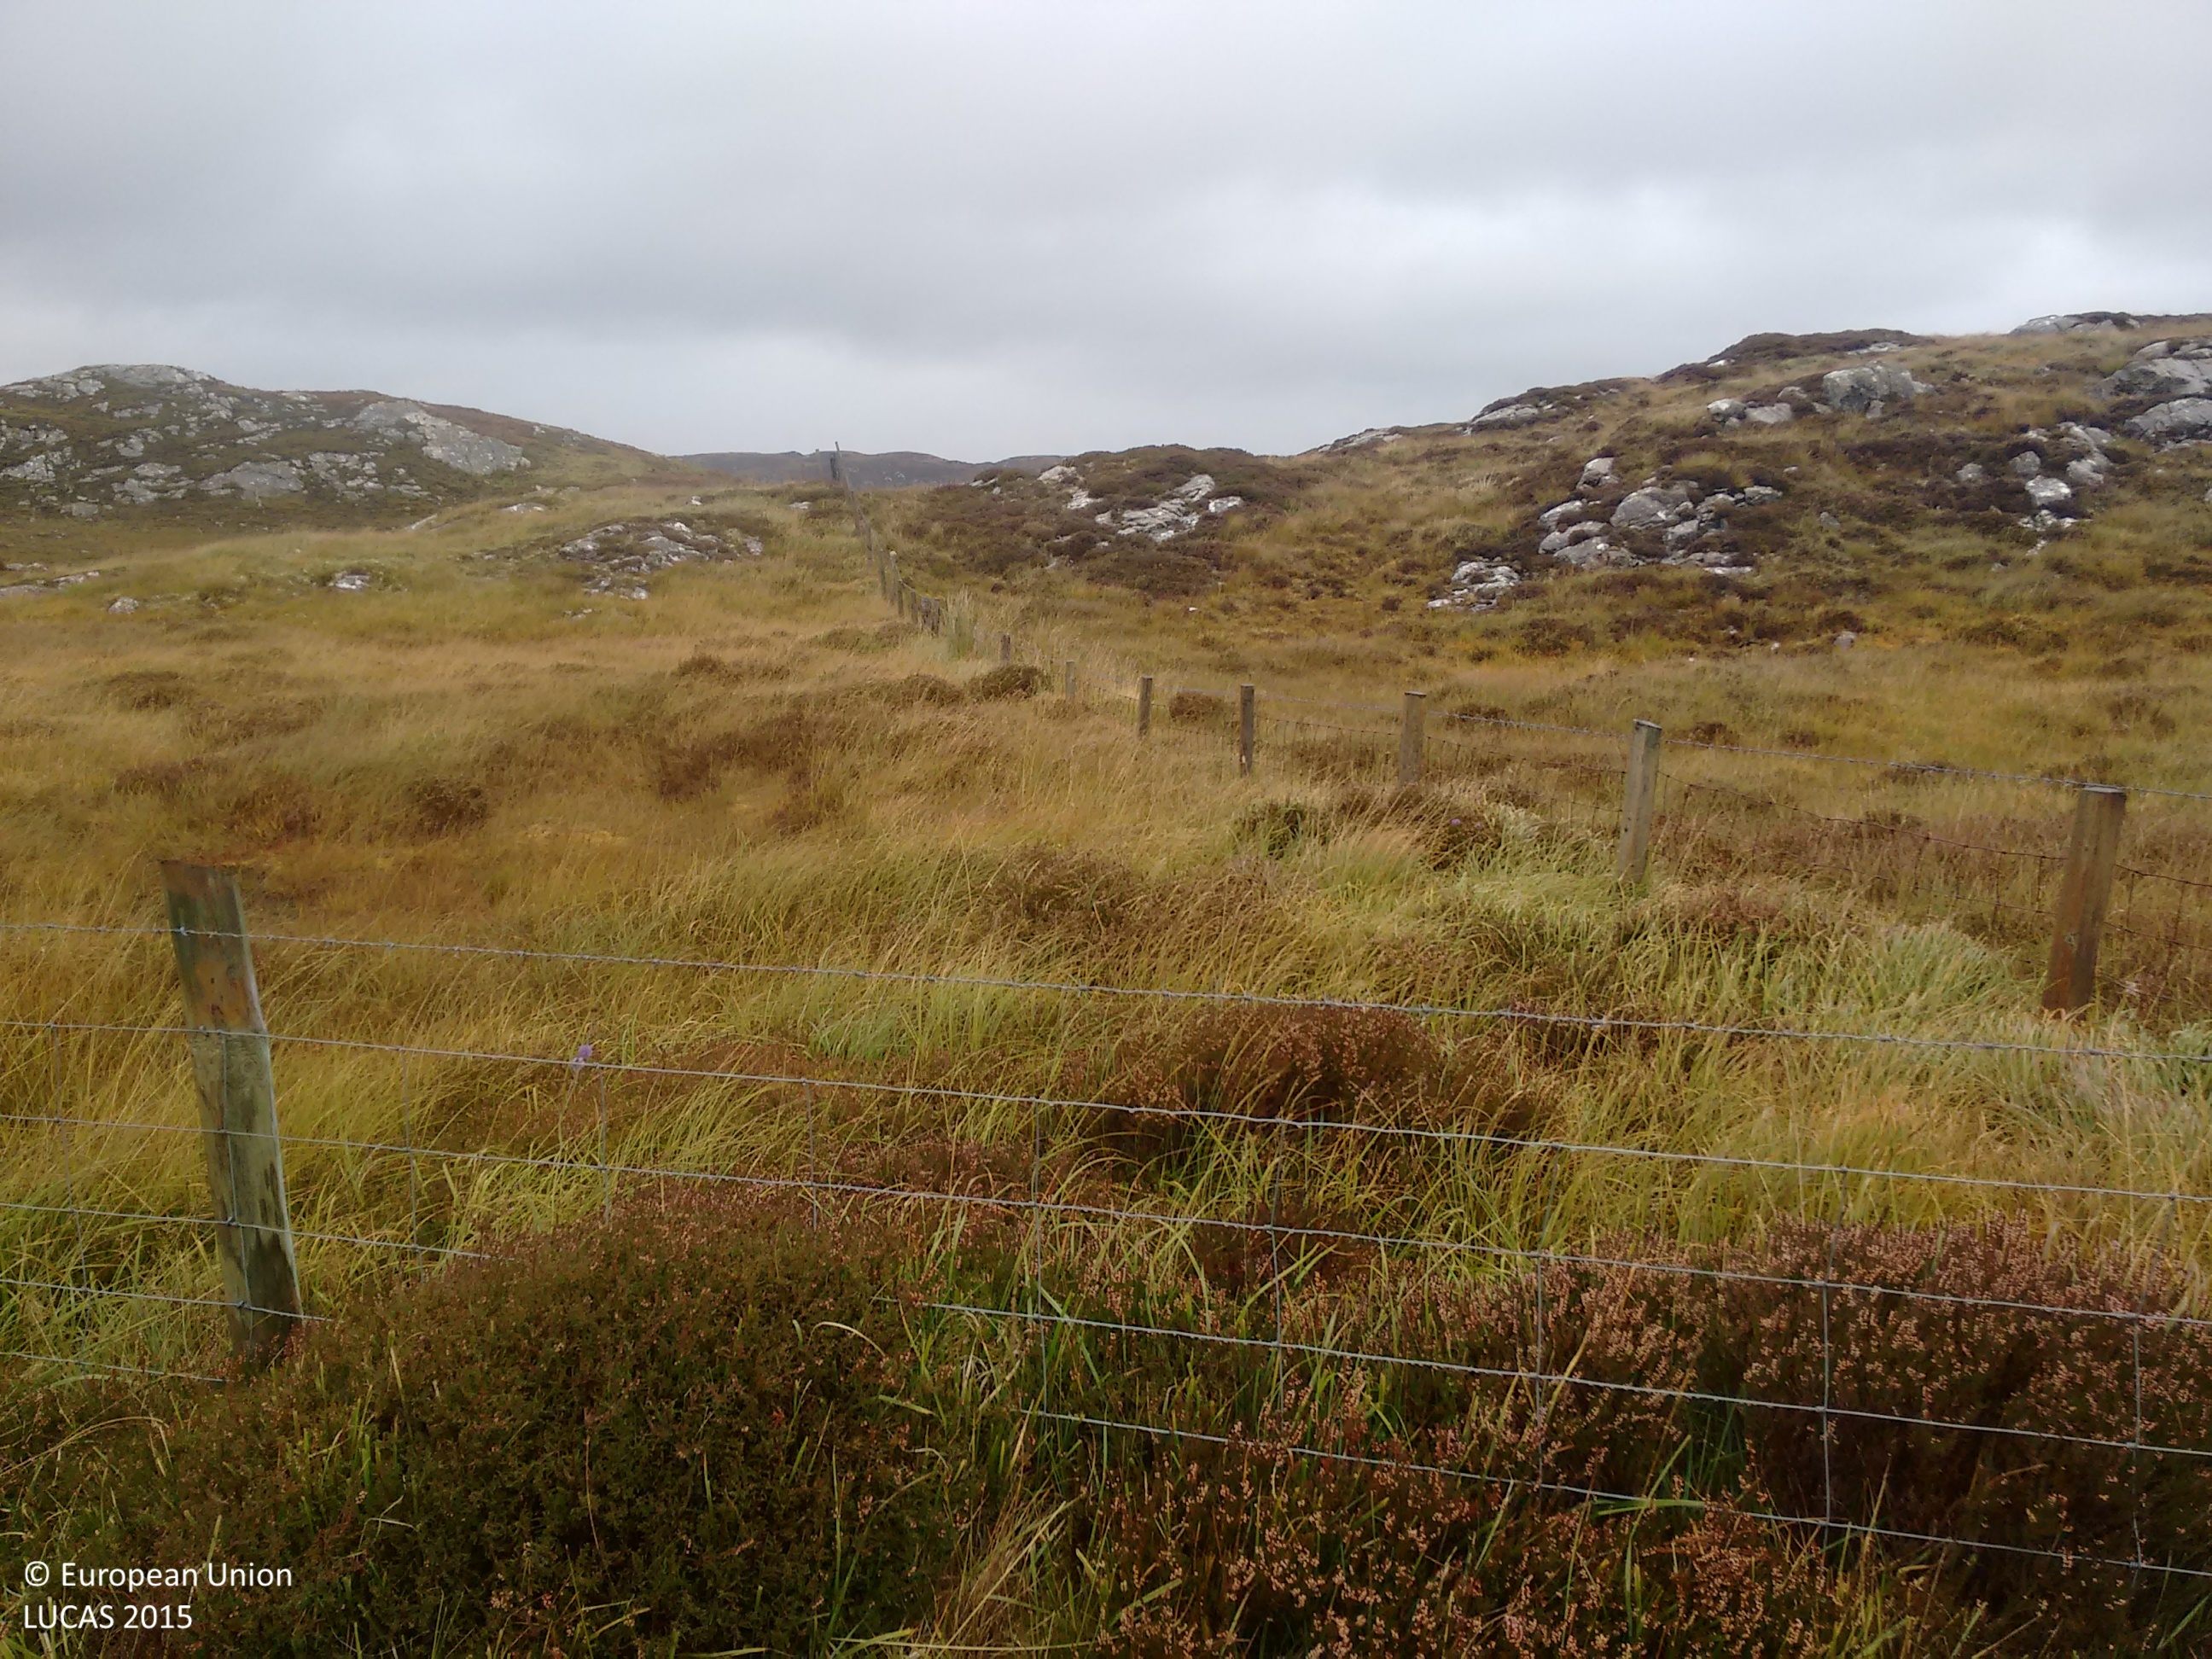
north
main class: Shrubland
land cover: Shrubland without tree cover
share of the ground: > 75 %
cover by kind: herbaceous plants 60 %, shrubs 40 %
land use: Agriculture (excluding fallow land and kitchen gardens)
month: October
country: GB
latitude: 58.1419
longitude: -6.3915
